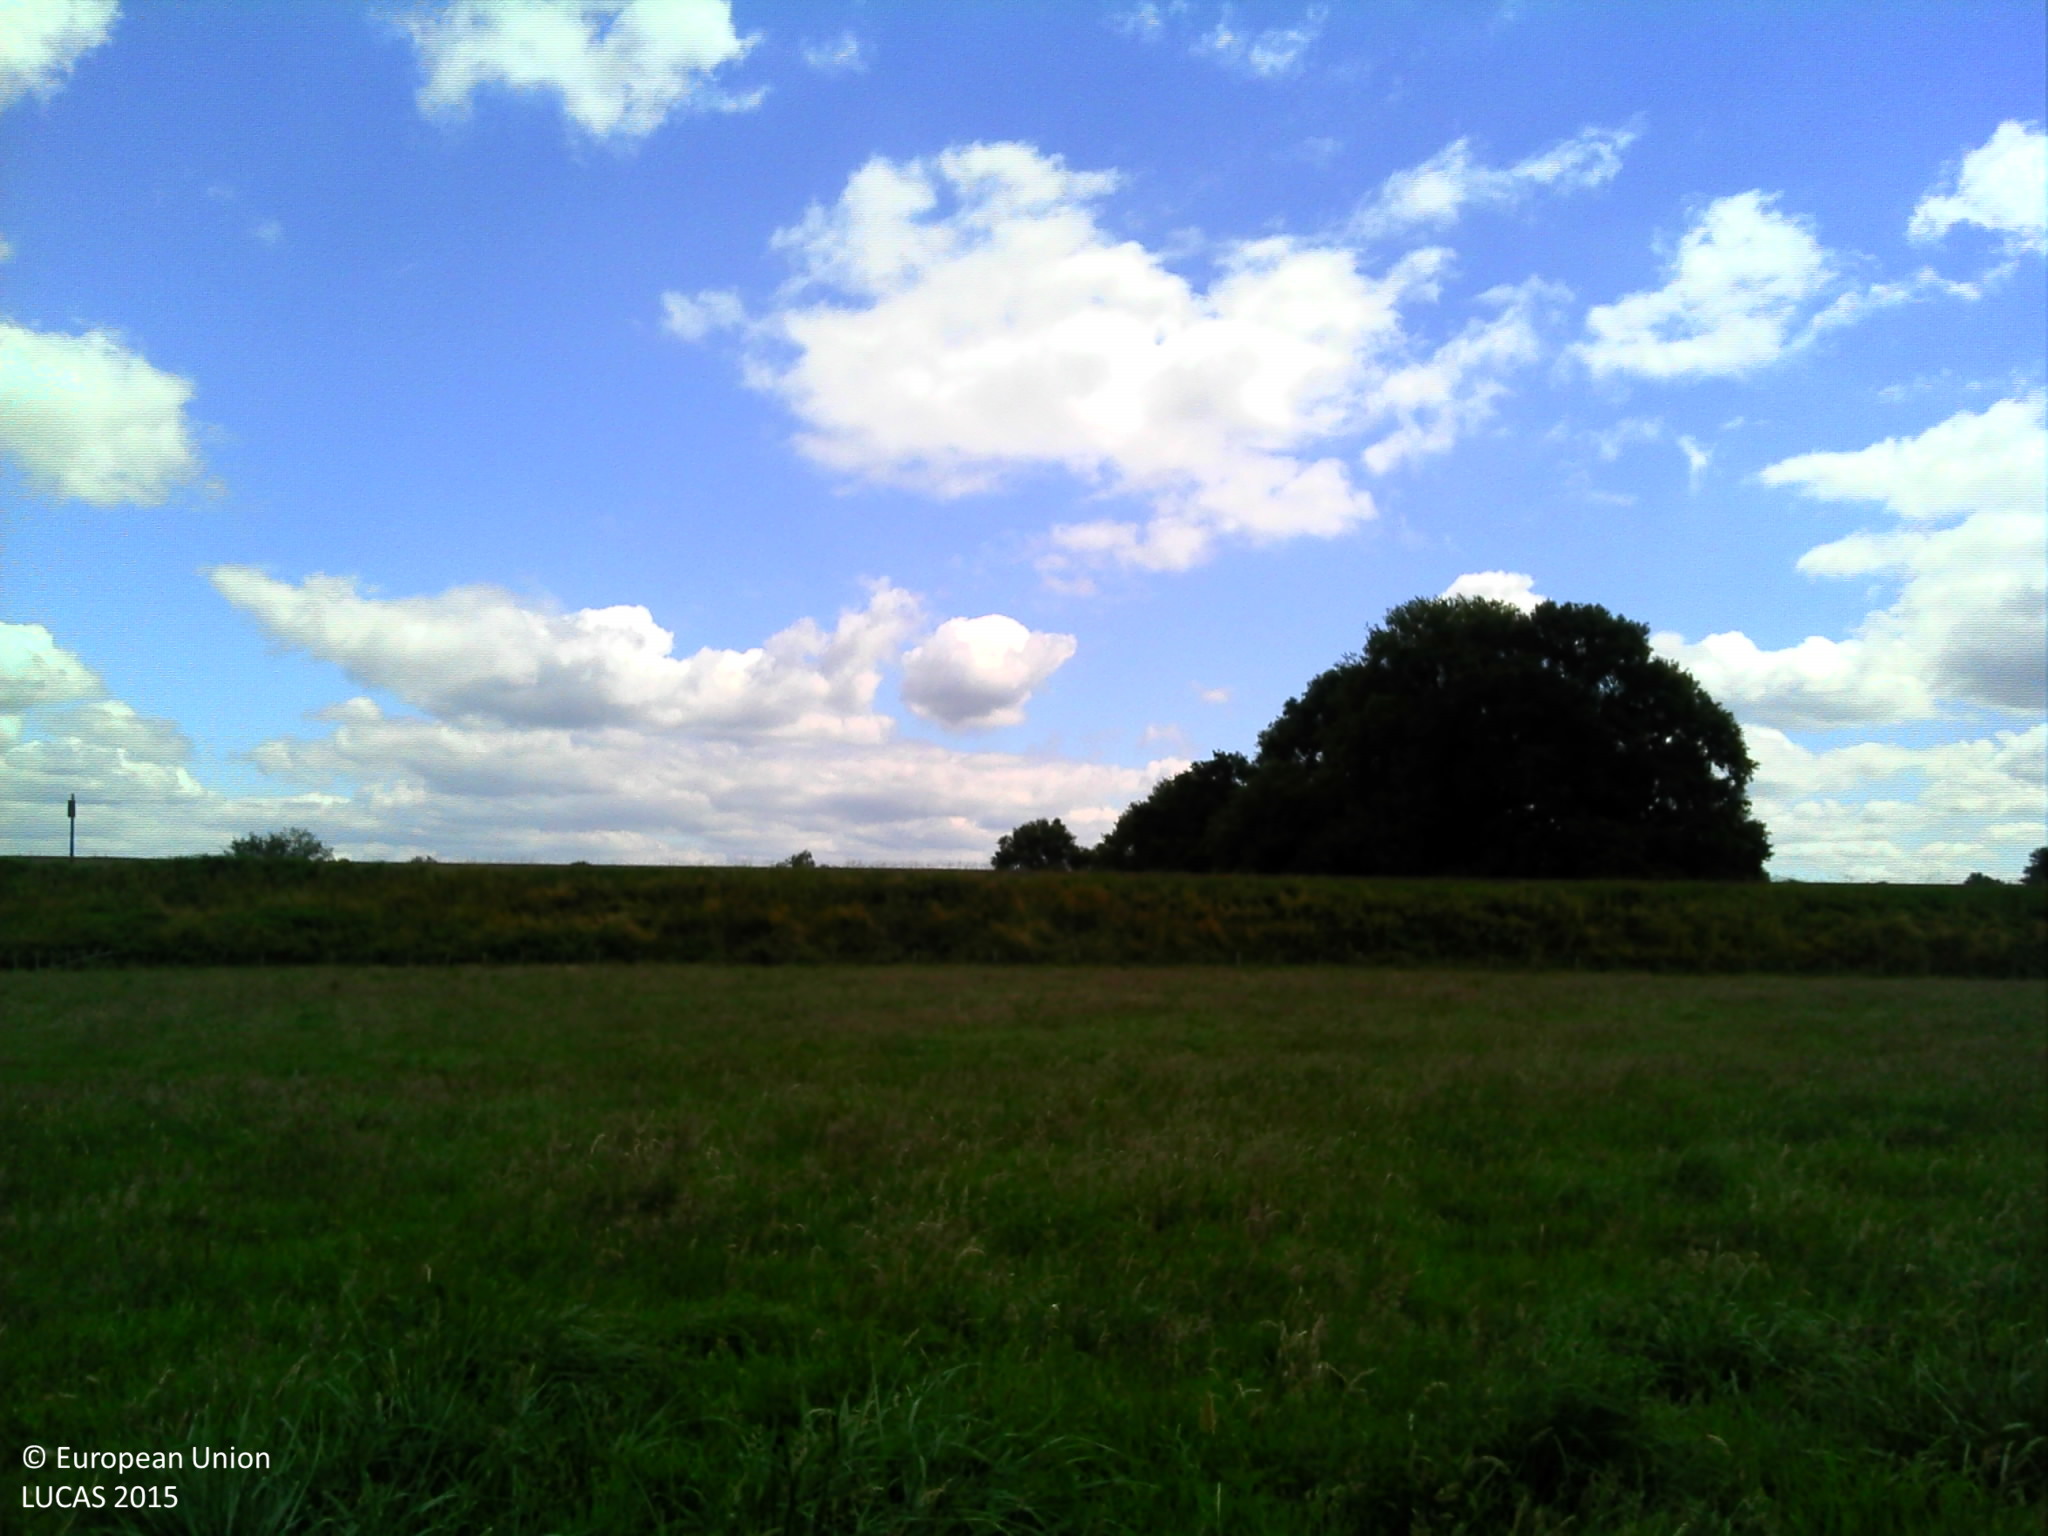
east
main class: Grassland
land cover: Grassland without tree/shrub cover
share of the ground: > 75 %
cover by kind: herbaceous plants 100 %
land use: Agriculture (excluding fallow land and kitchen gardens)
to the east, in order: Grassland without tree/shrub cover; Fences; Ditches and canals; Grassland without tree/shrub cover; Railways; Grassland without tree/shrub cover; Ditches and canals; Fences; Grassland without tree/shrub cover; Fences; Grassland without tree/shrub cover
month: June
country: FR
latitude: 47.8433
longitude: 0.2338
